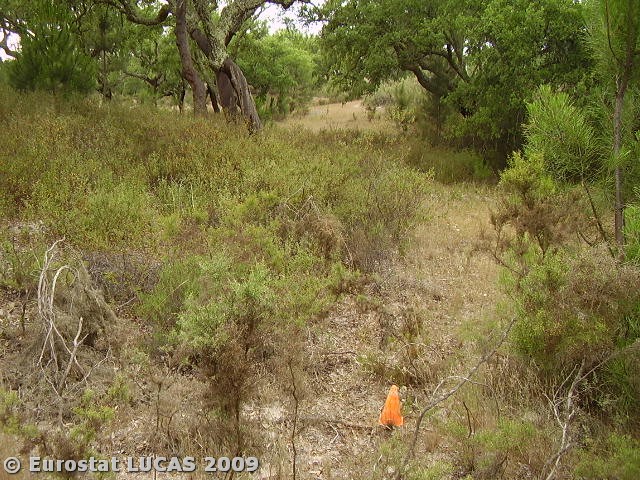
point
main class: Woodland
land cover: Broadleaved woodland
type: broadleaved evergreen forest
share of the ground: 25 - 50 %
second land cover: Spontaneously vegetated surfaces
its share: 25 - 50 %
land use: Forestry
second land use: Fallow land
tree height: > 5 m
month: June
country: PT
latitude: 38.9019
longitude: -8.1908
